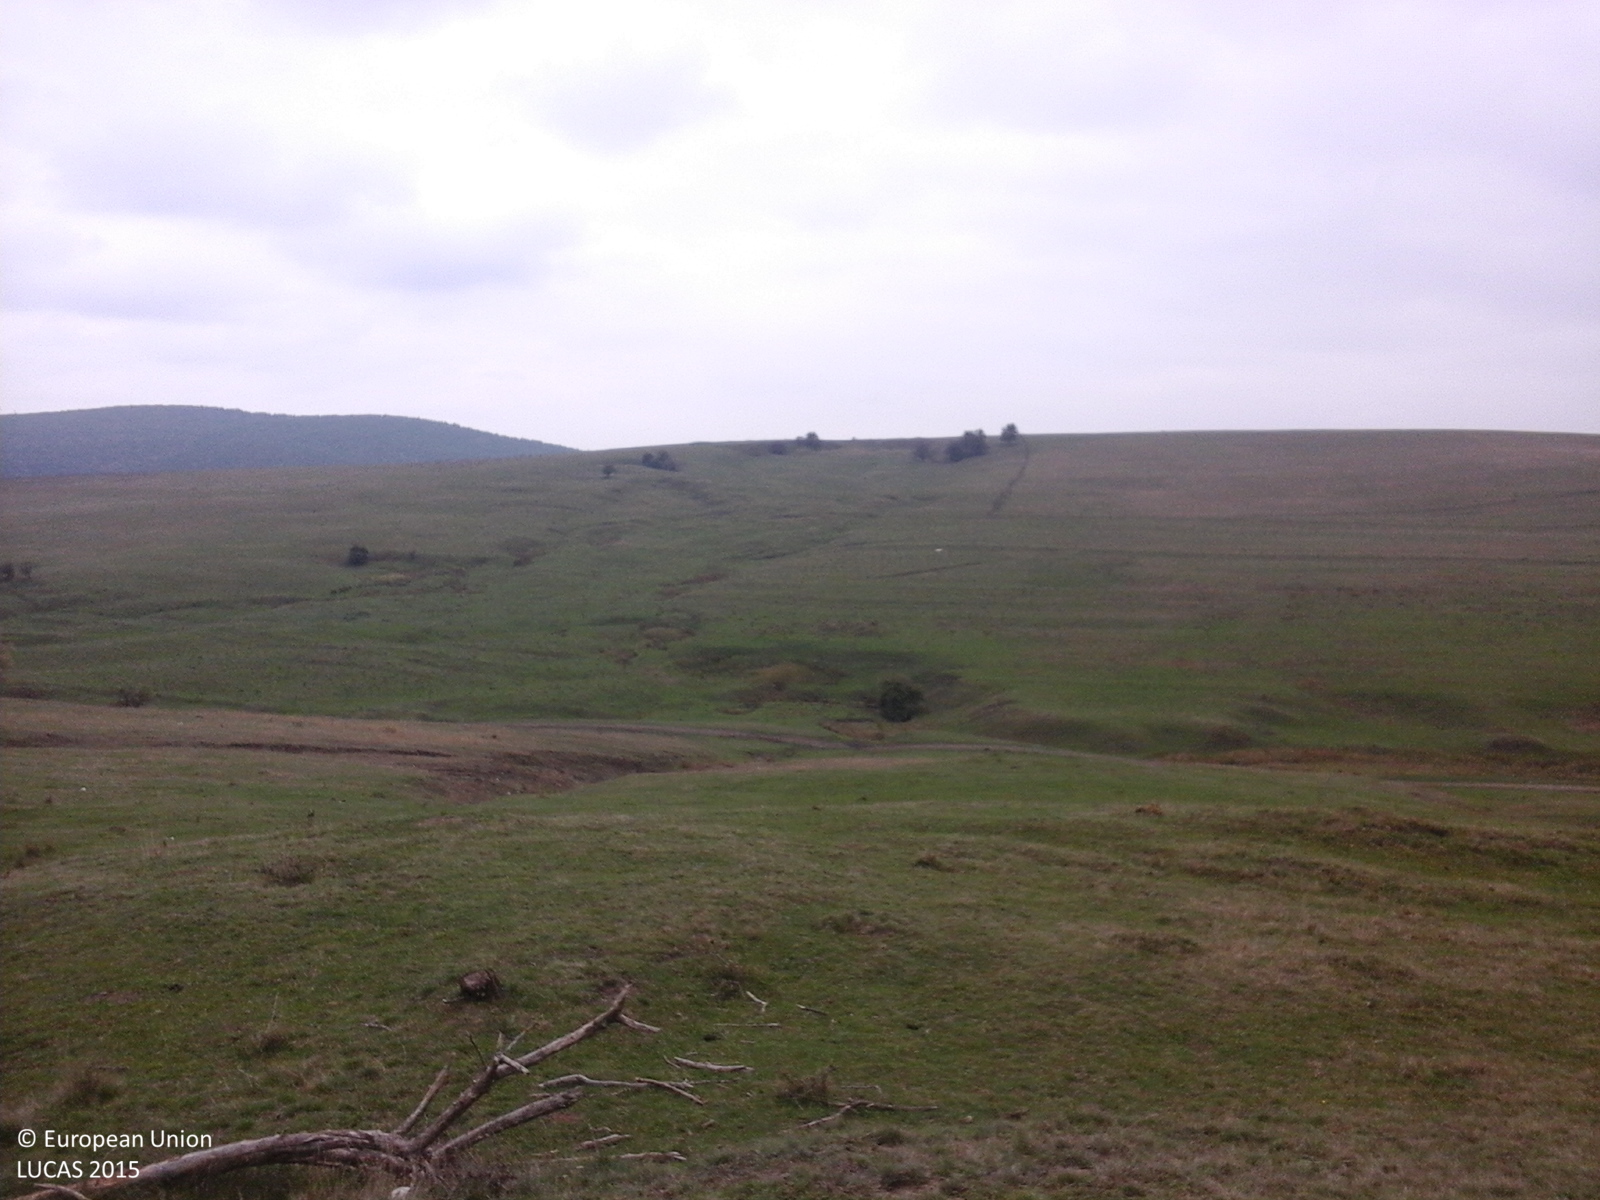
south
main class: Grassland
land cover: Grassland without tree/shrub cover
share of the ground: > 75 %
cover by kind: herbaceous plants 100 %
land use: Agriculture (excluding fallow land and kitchen gardens)
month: October
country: RO
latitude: 46.0196
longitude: 25.1189
